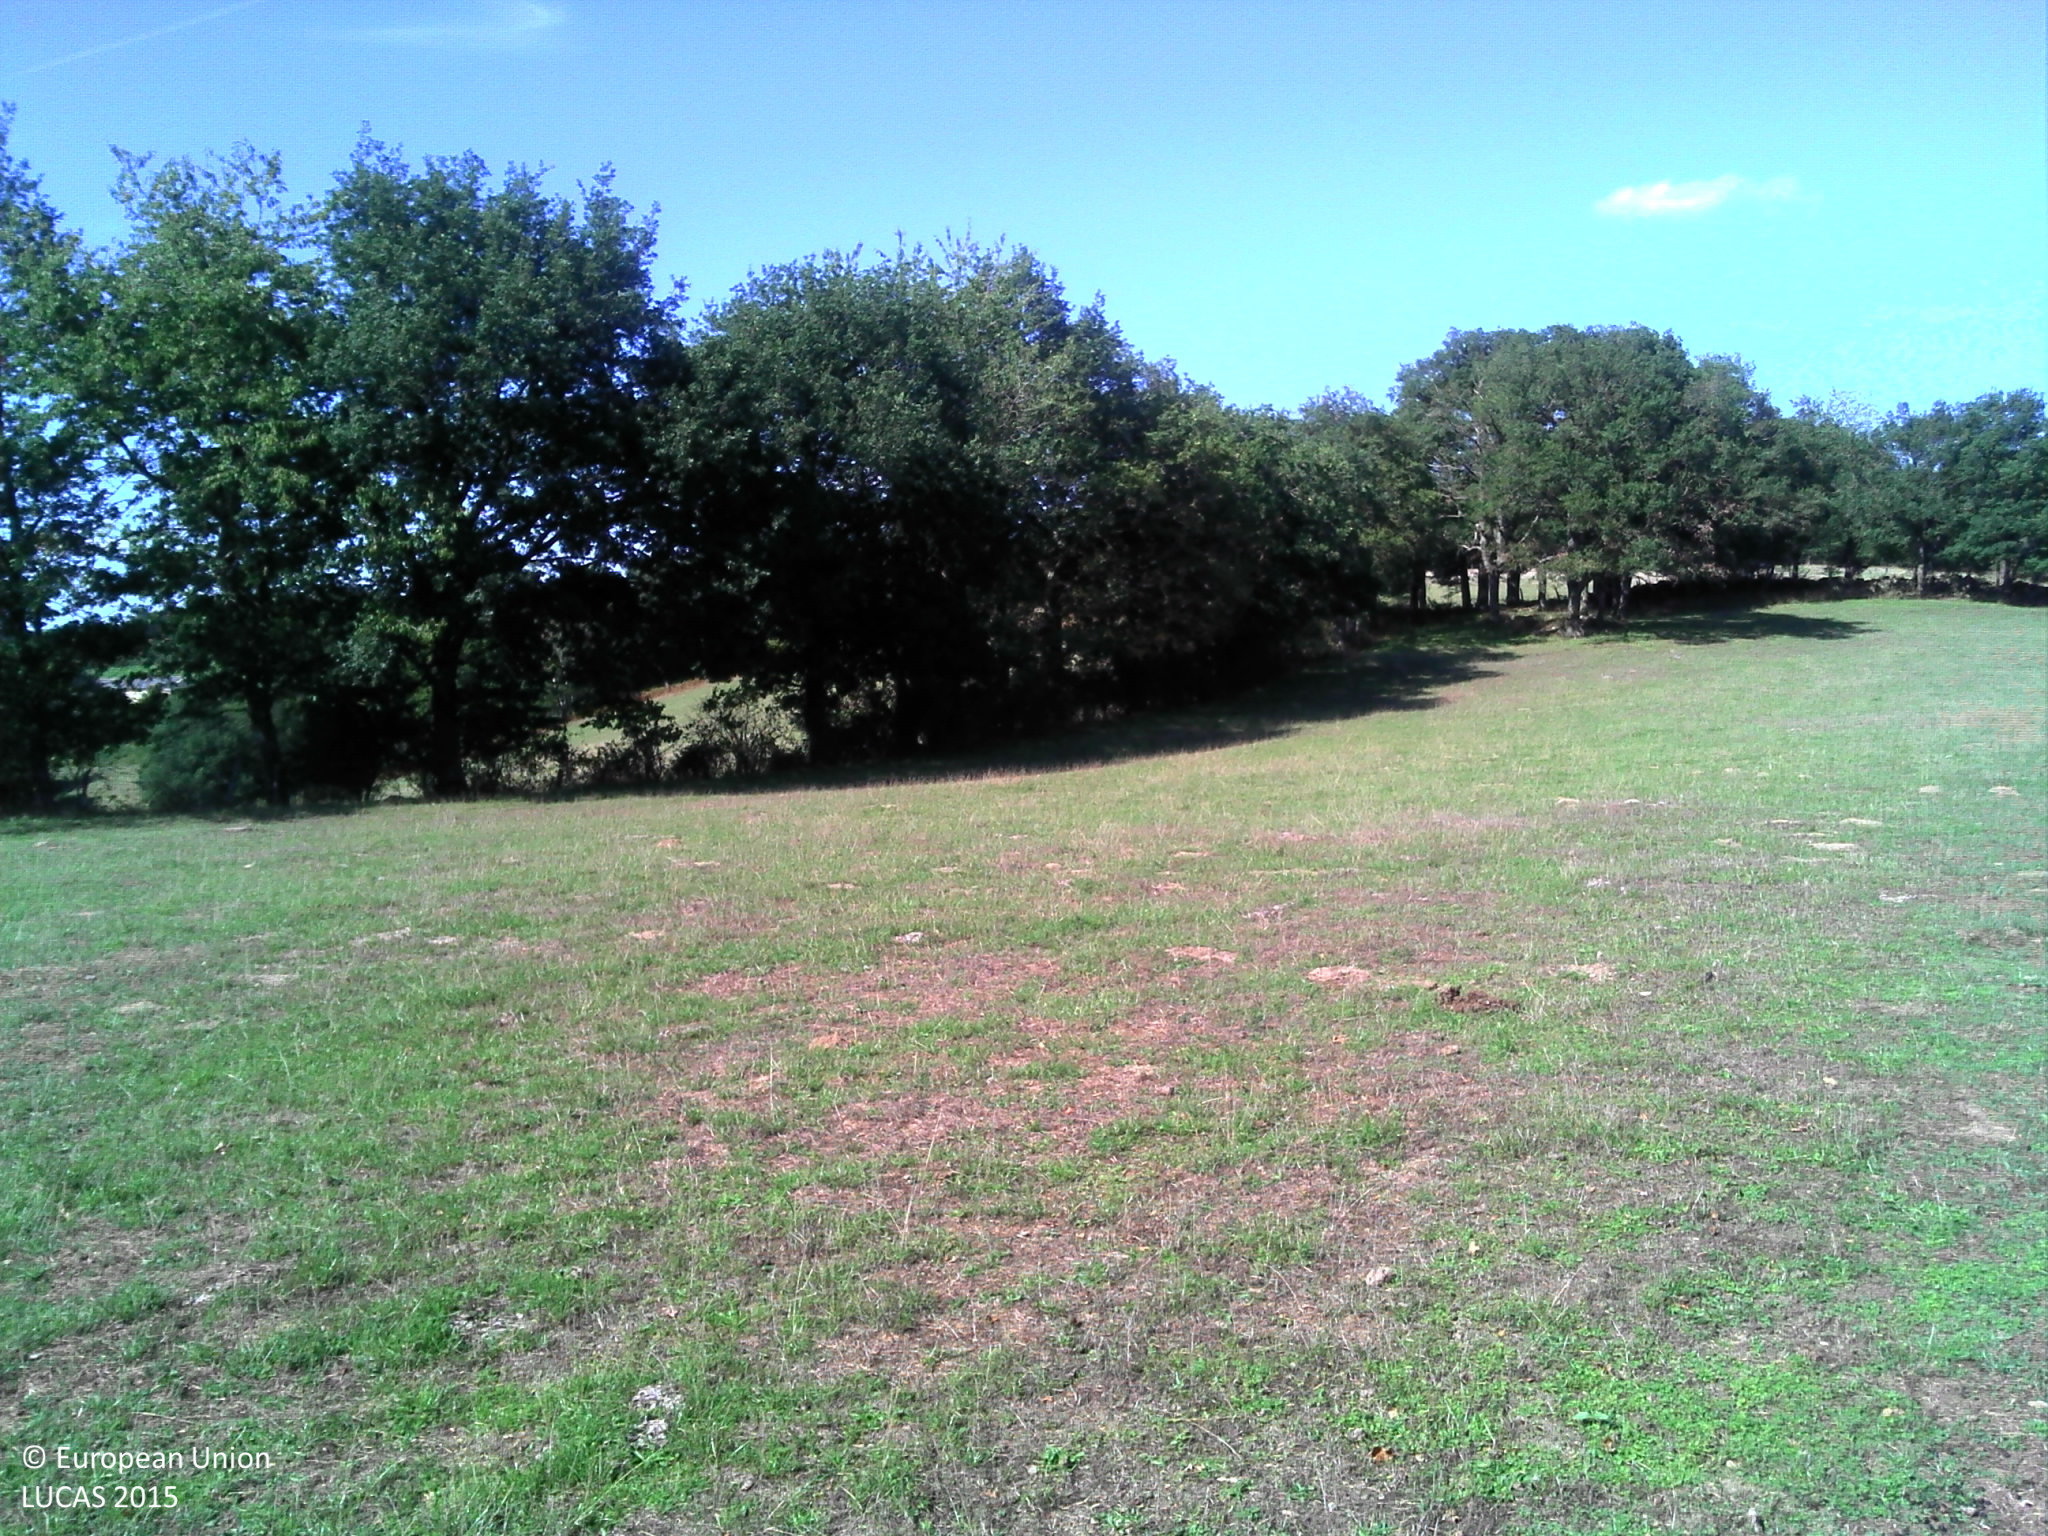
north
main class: Grassland
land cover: Grassland without tree/shrub cover
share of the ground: > 75 %
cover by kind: herbaceous plants 100 %
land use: Agriculture (excluding fallow land and kitchen gardens)
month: August
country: FR
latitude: 45.9106
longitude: 2.2998
